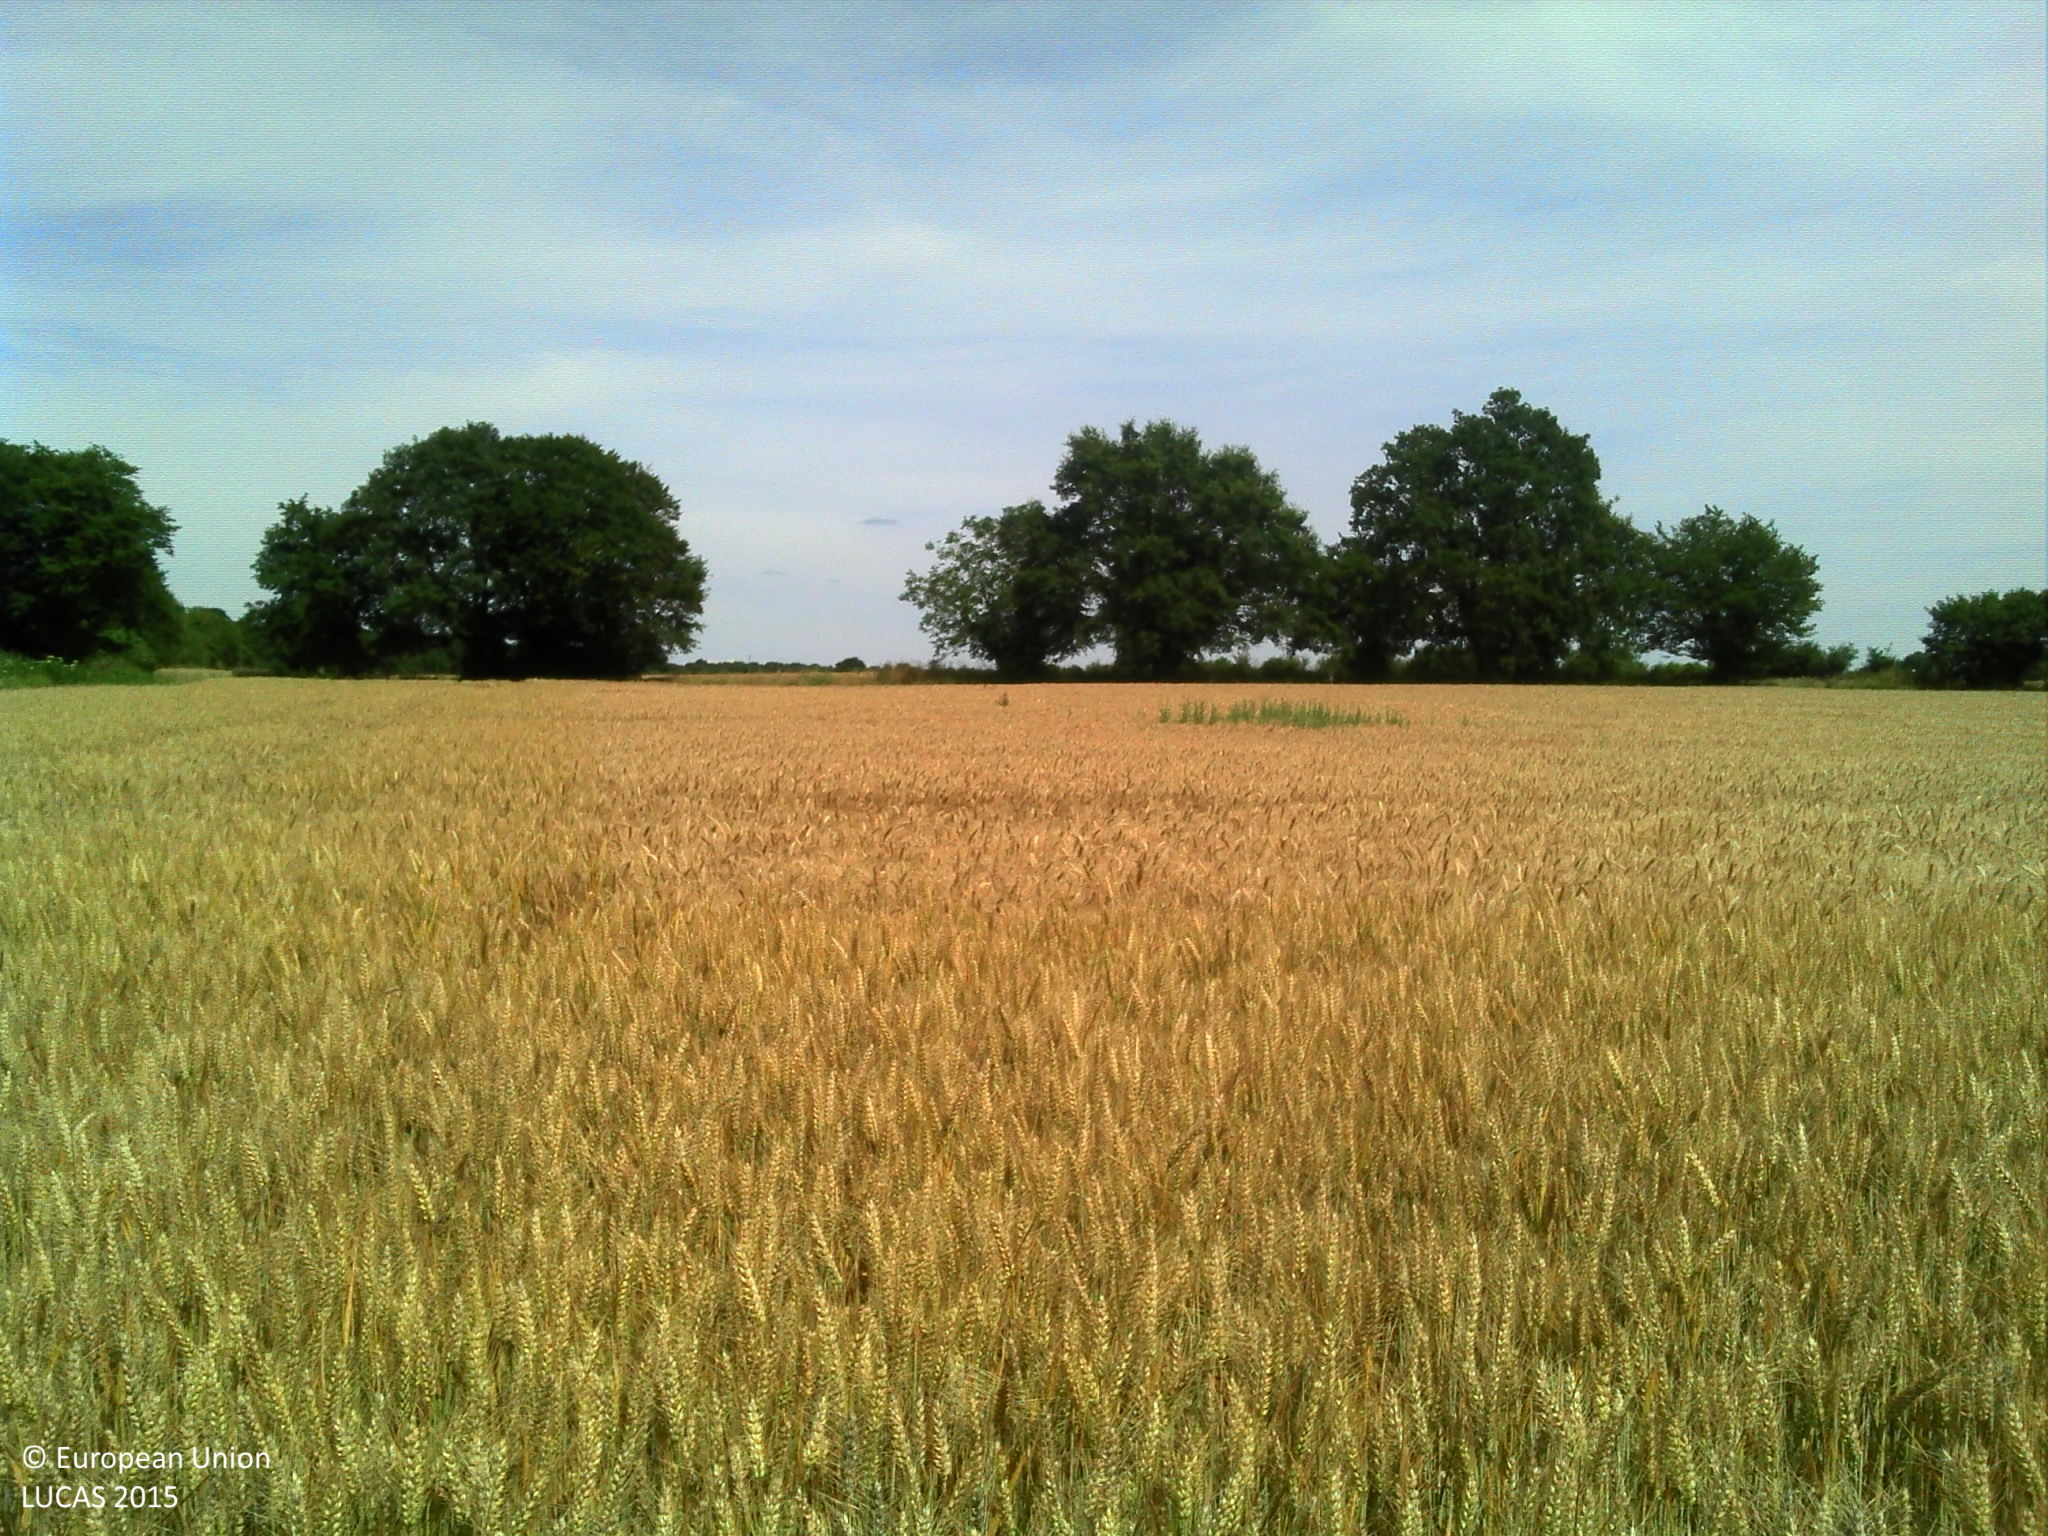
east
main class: Cropland
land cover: Common wheat
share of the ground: > 75 %
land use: Agriculture (excluding fallow land and kitchen gardens)
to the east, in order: Common wheat; Tracks; Broadleaved woodland; Common wheat
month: June
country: FR
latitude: 47.0942
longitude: 2.9469
